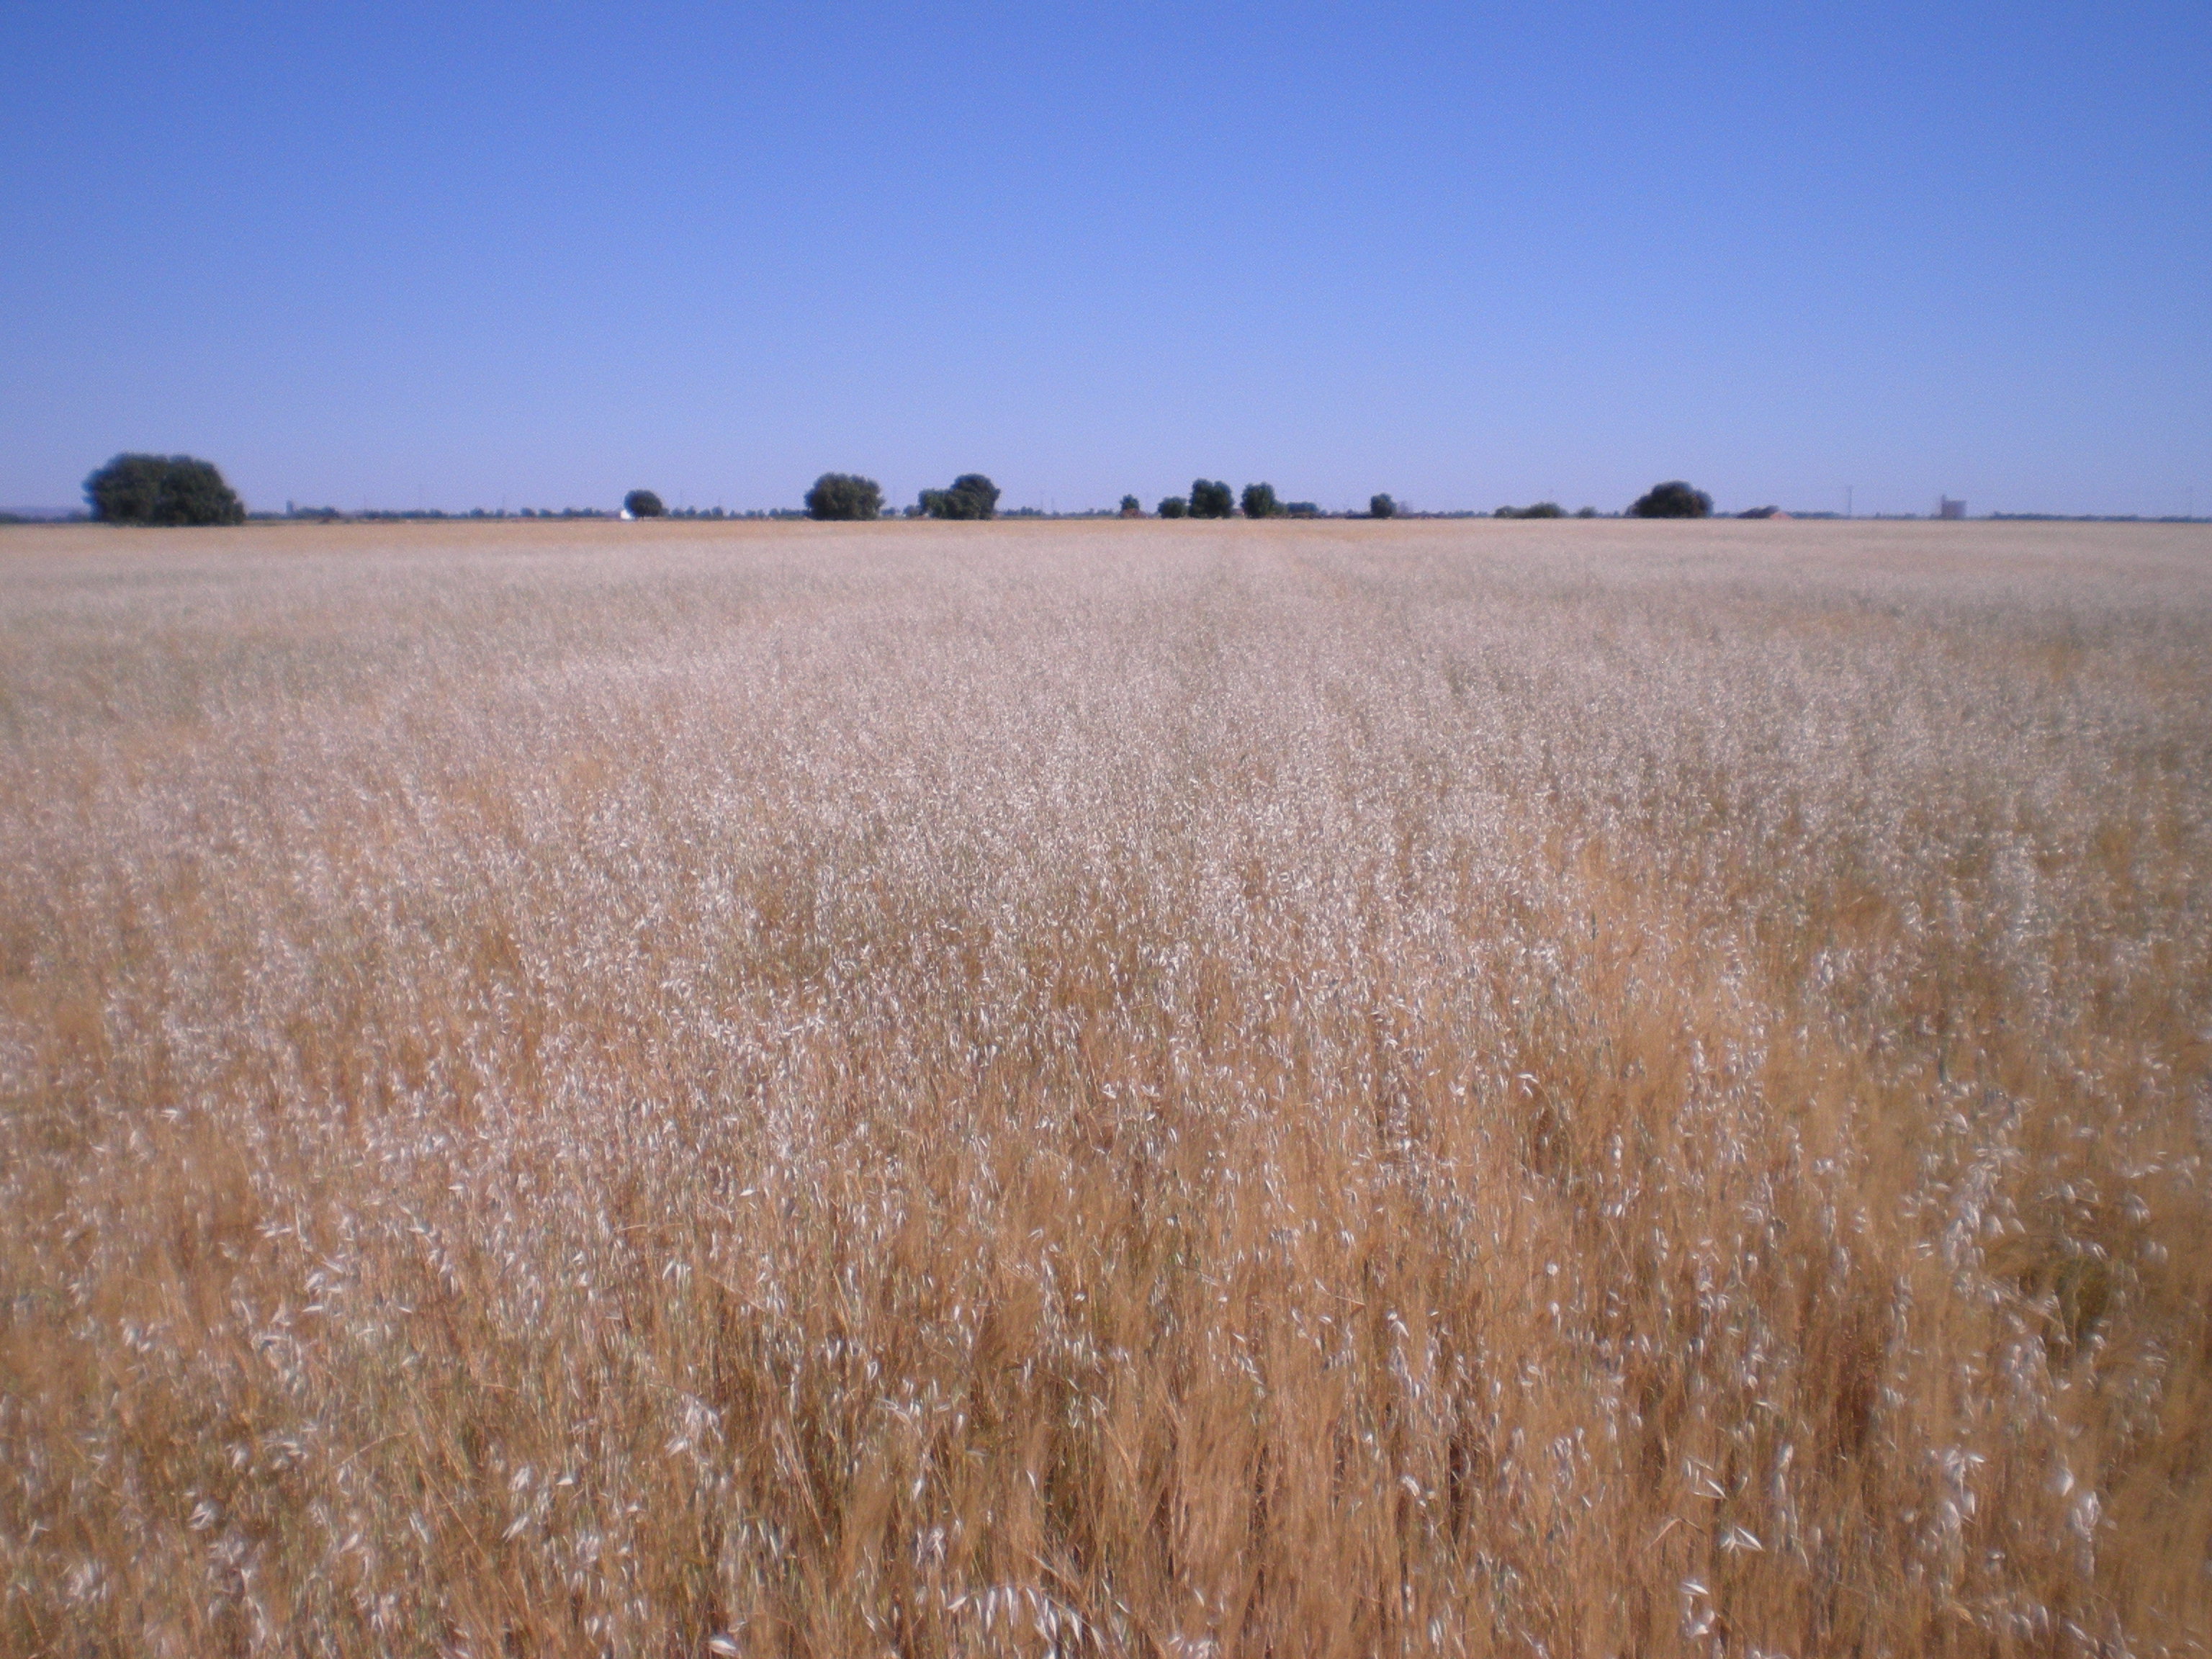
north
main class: Cropland
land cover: Barley
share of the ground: > 75 %
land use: Agriculture (excluding fallow land and kitchen gardens)
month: May
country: ES
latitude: 39.1071
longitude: -3.2554
